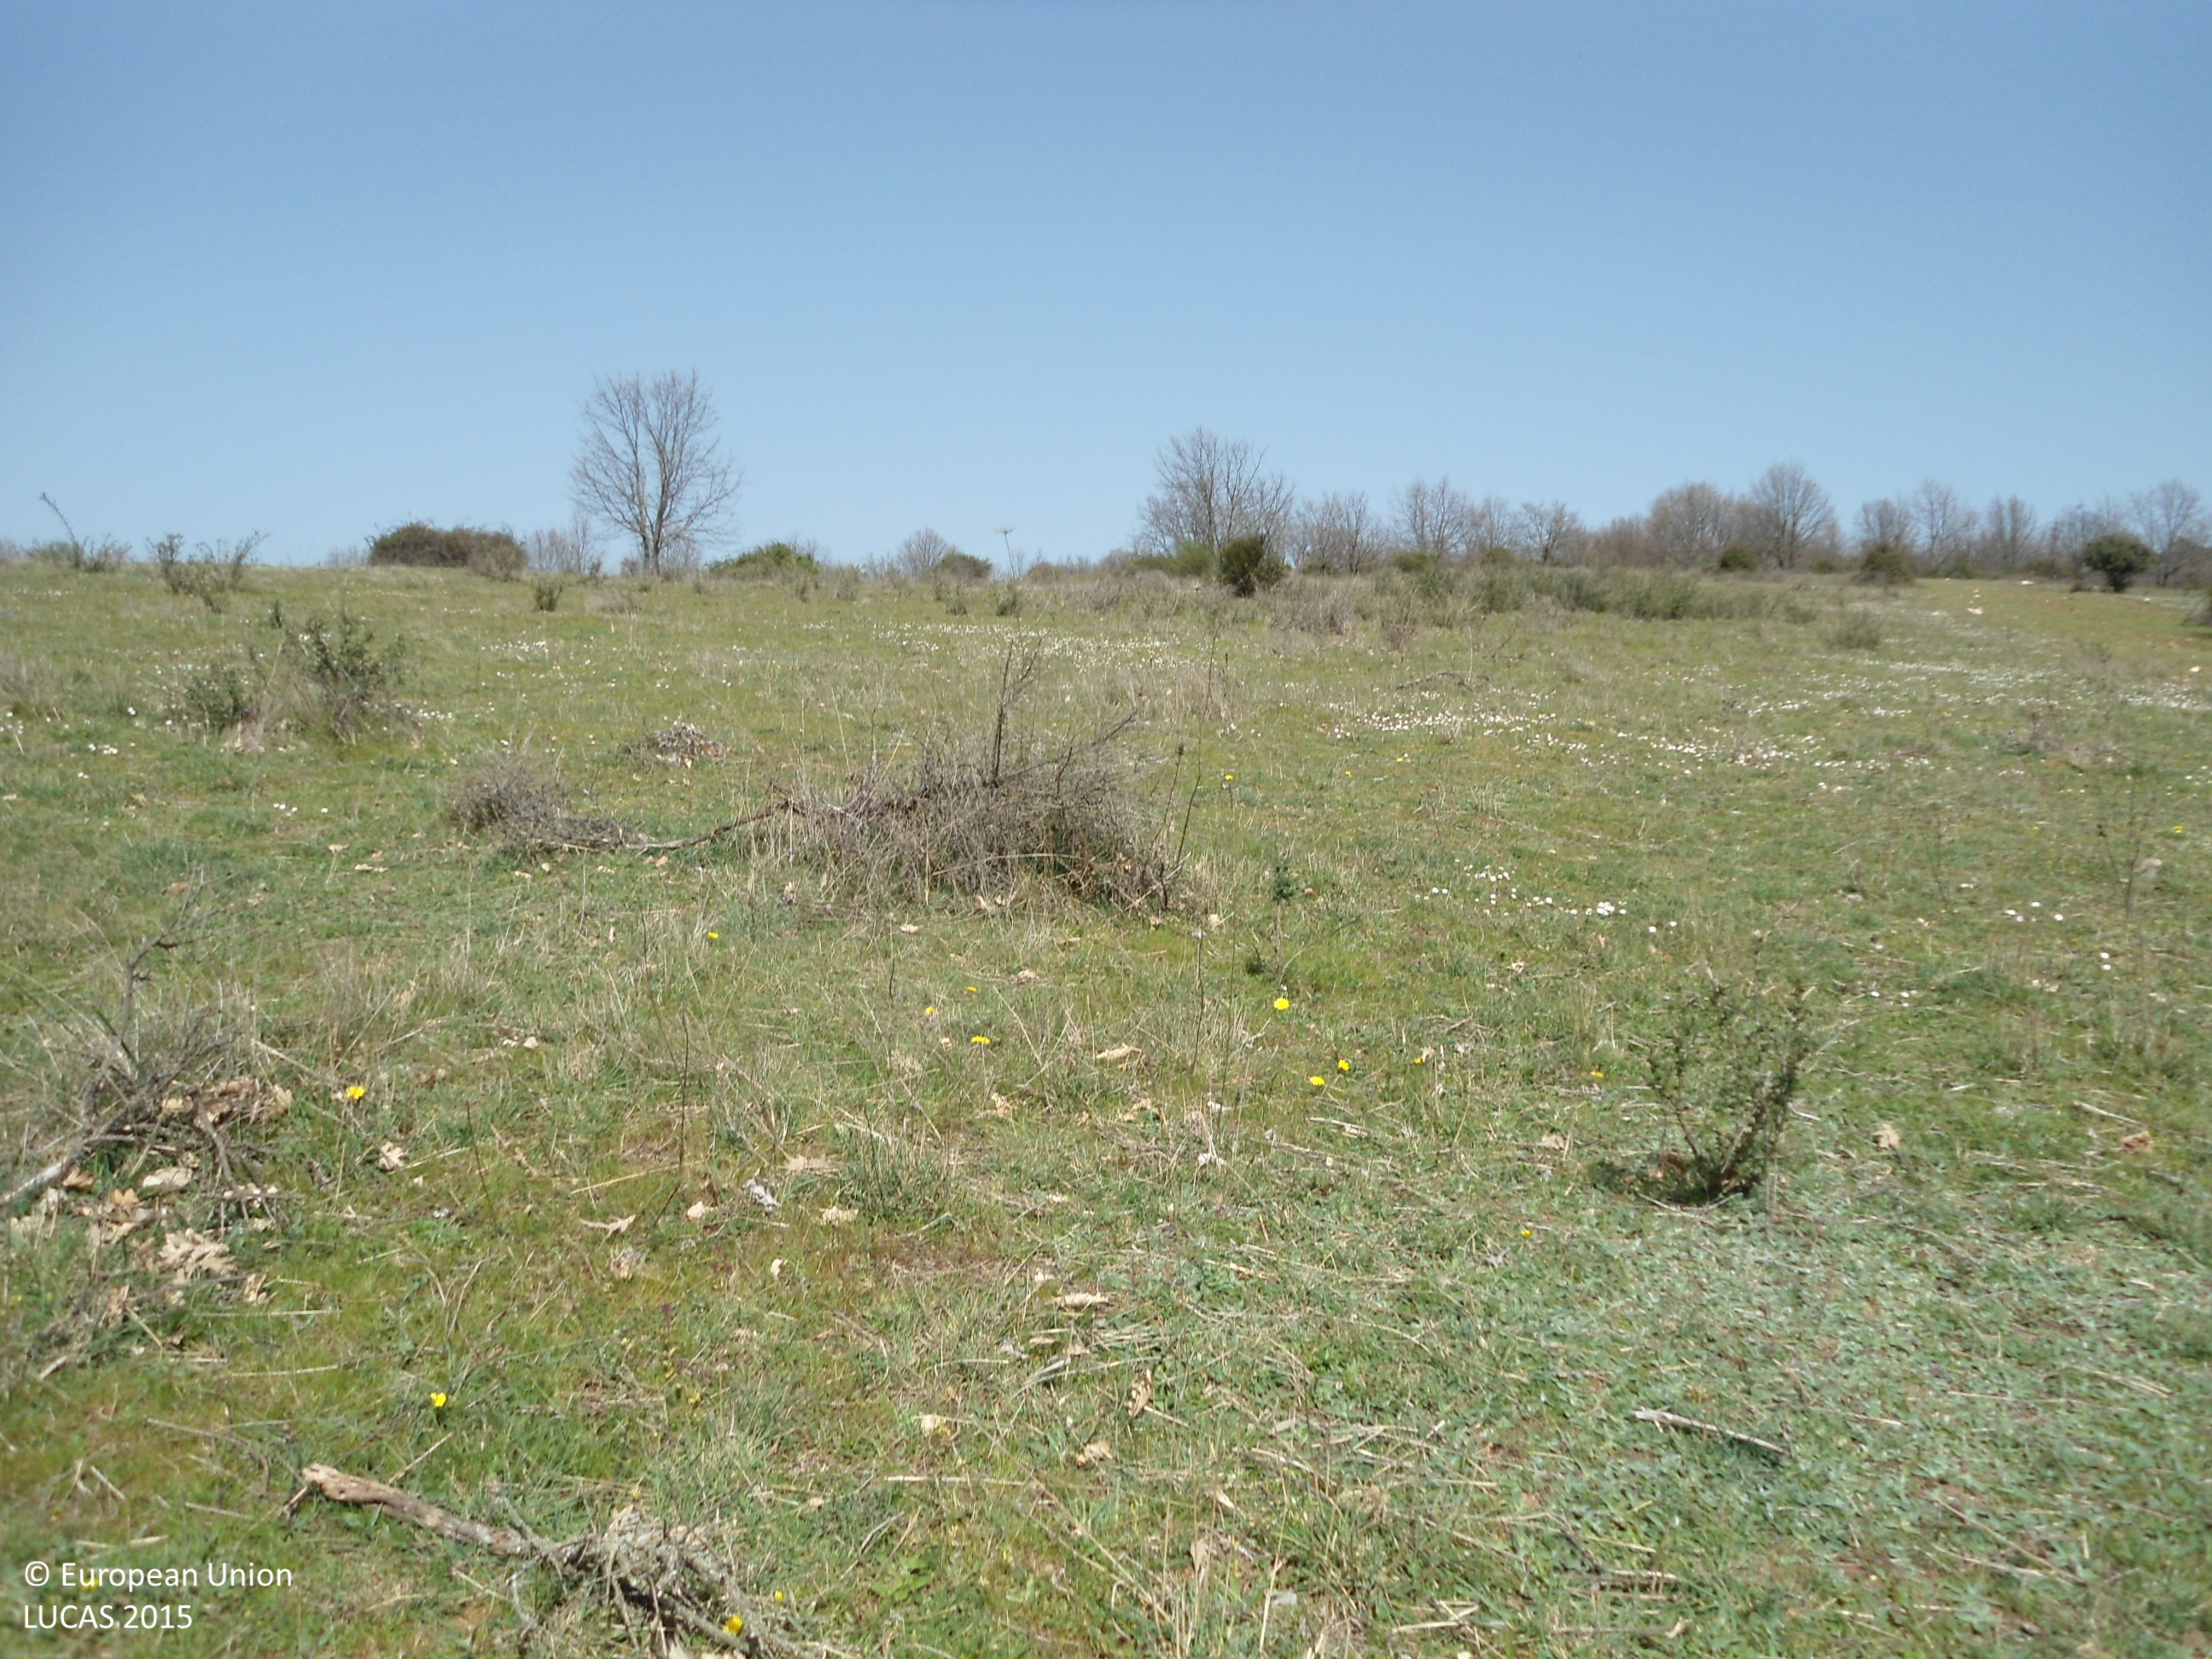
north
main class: Grassland
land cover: Grassland without tree/shrub cover
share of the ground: > 75 %
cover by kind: herbaceous plants 95 %, shrubs 5 %
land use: Agriculture (excluding fallow land and kitchen gardens)
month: April
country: ES
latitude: 41.7443
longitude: -6.4221
